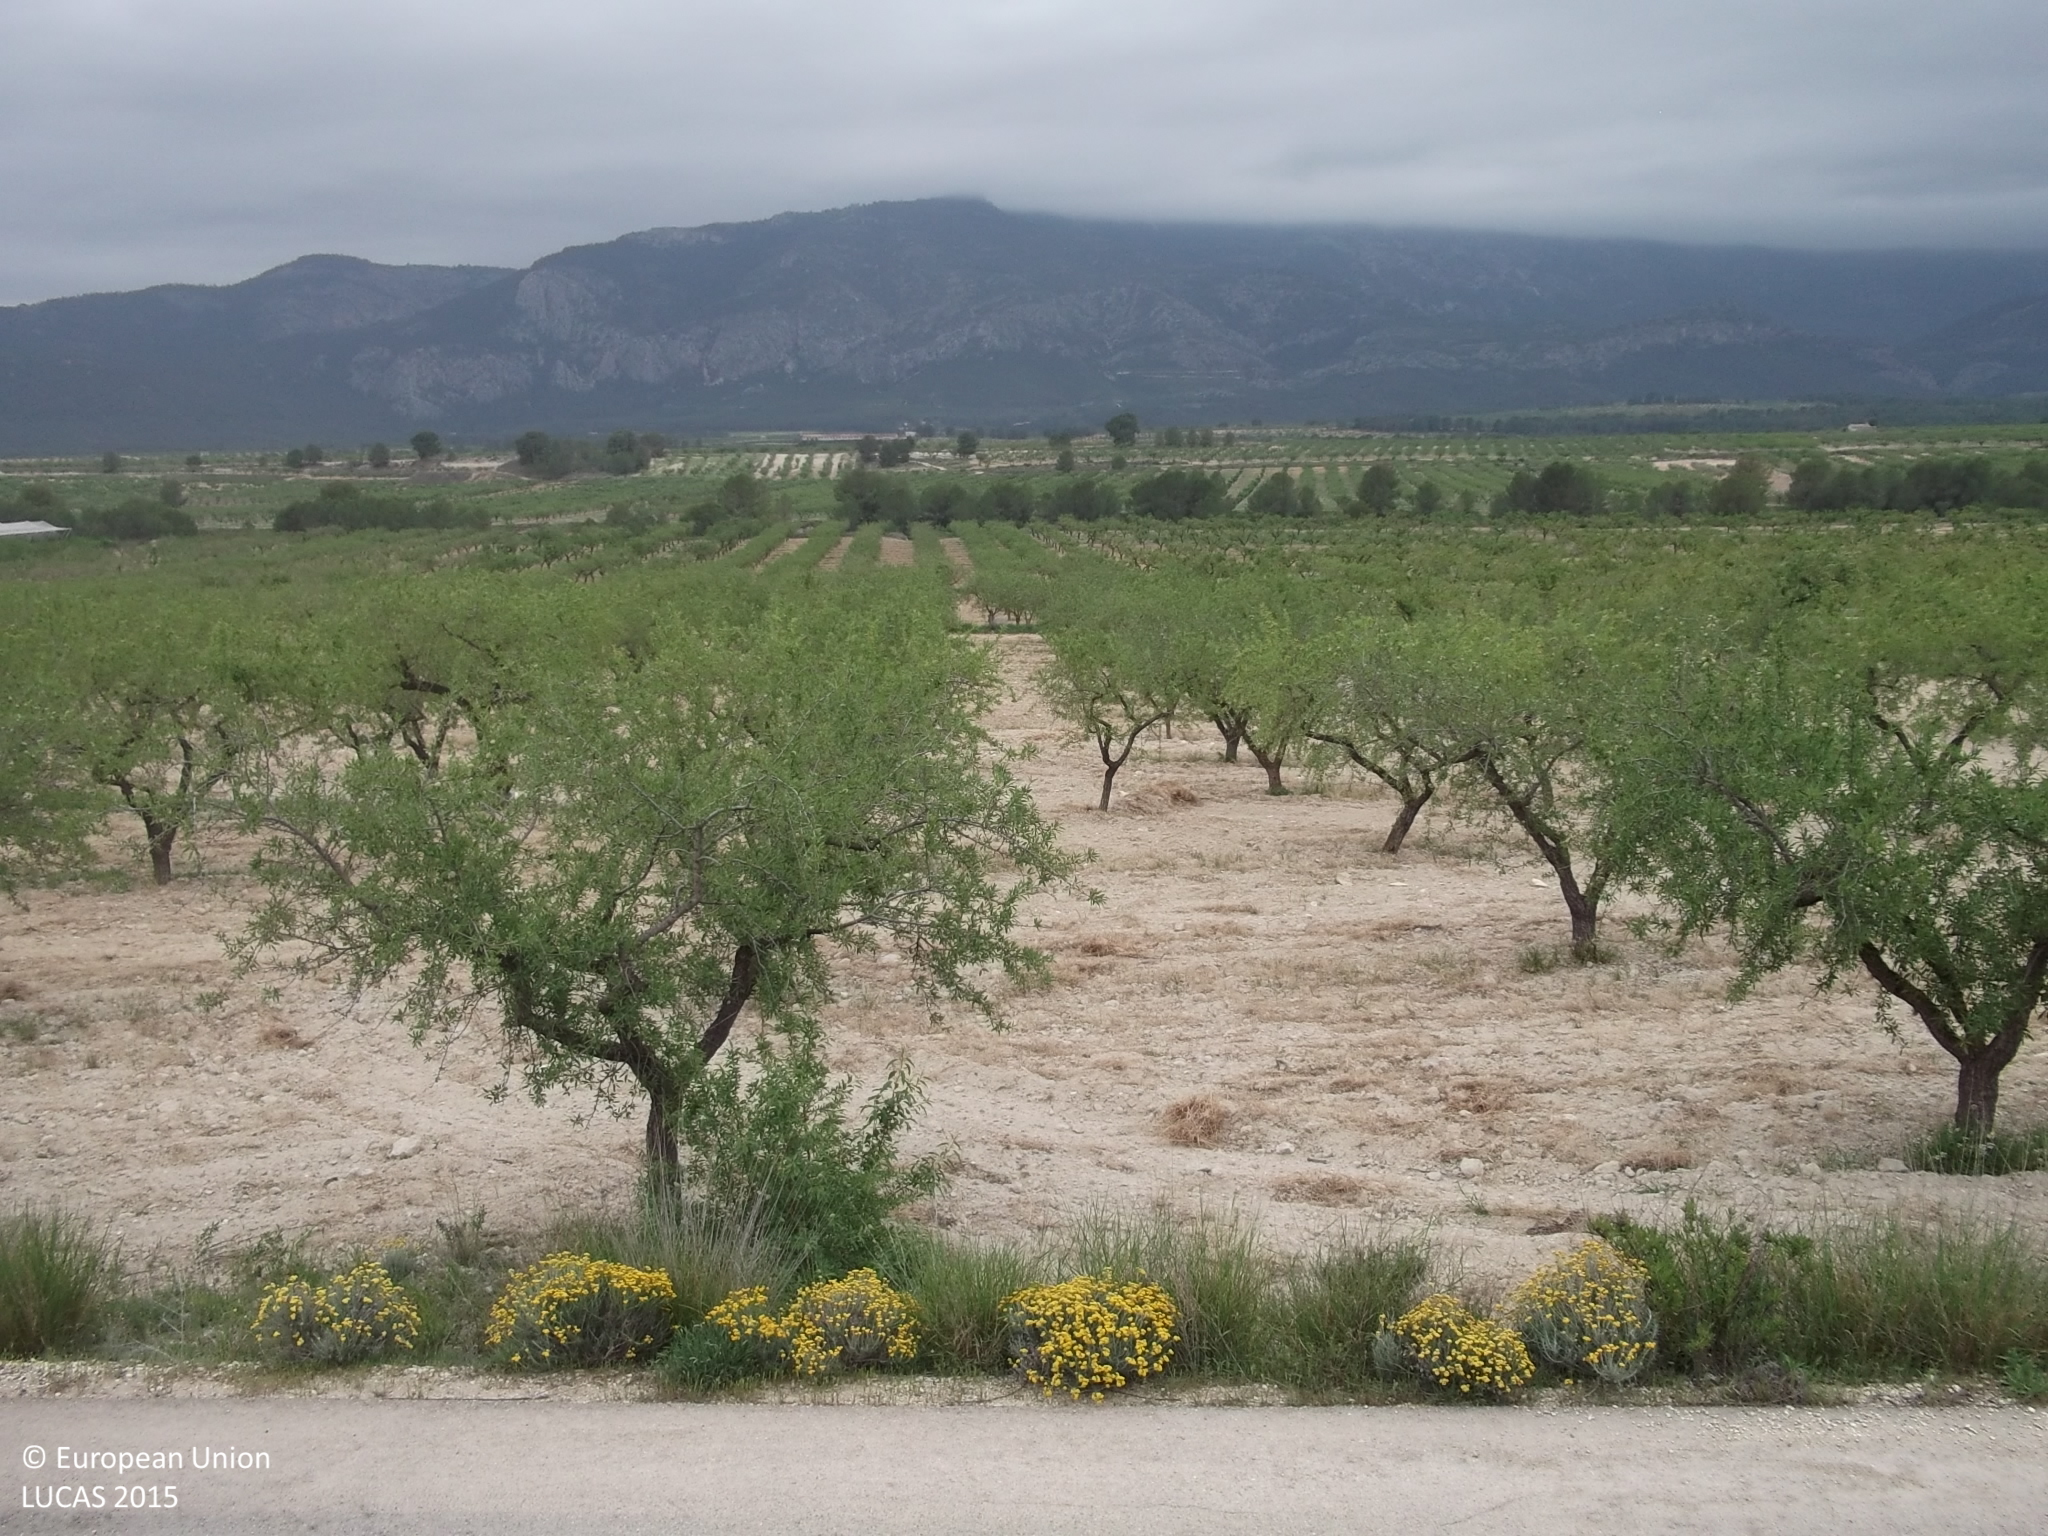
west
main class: Grassland
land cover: Grassland without tree/shrub cover
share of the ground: 10 - 25 %
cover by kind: consolidated bare surface 70 %, herbaceous plants 30 %
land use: Abandoned areas
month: April
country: ES
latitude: 37.9729
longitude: -1.5631
